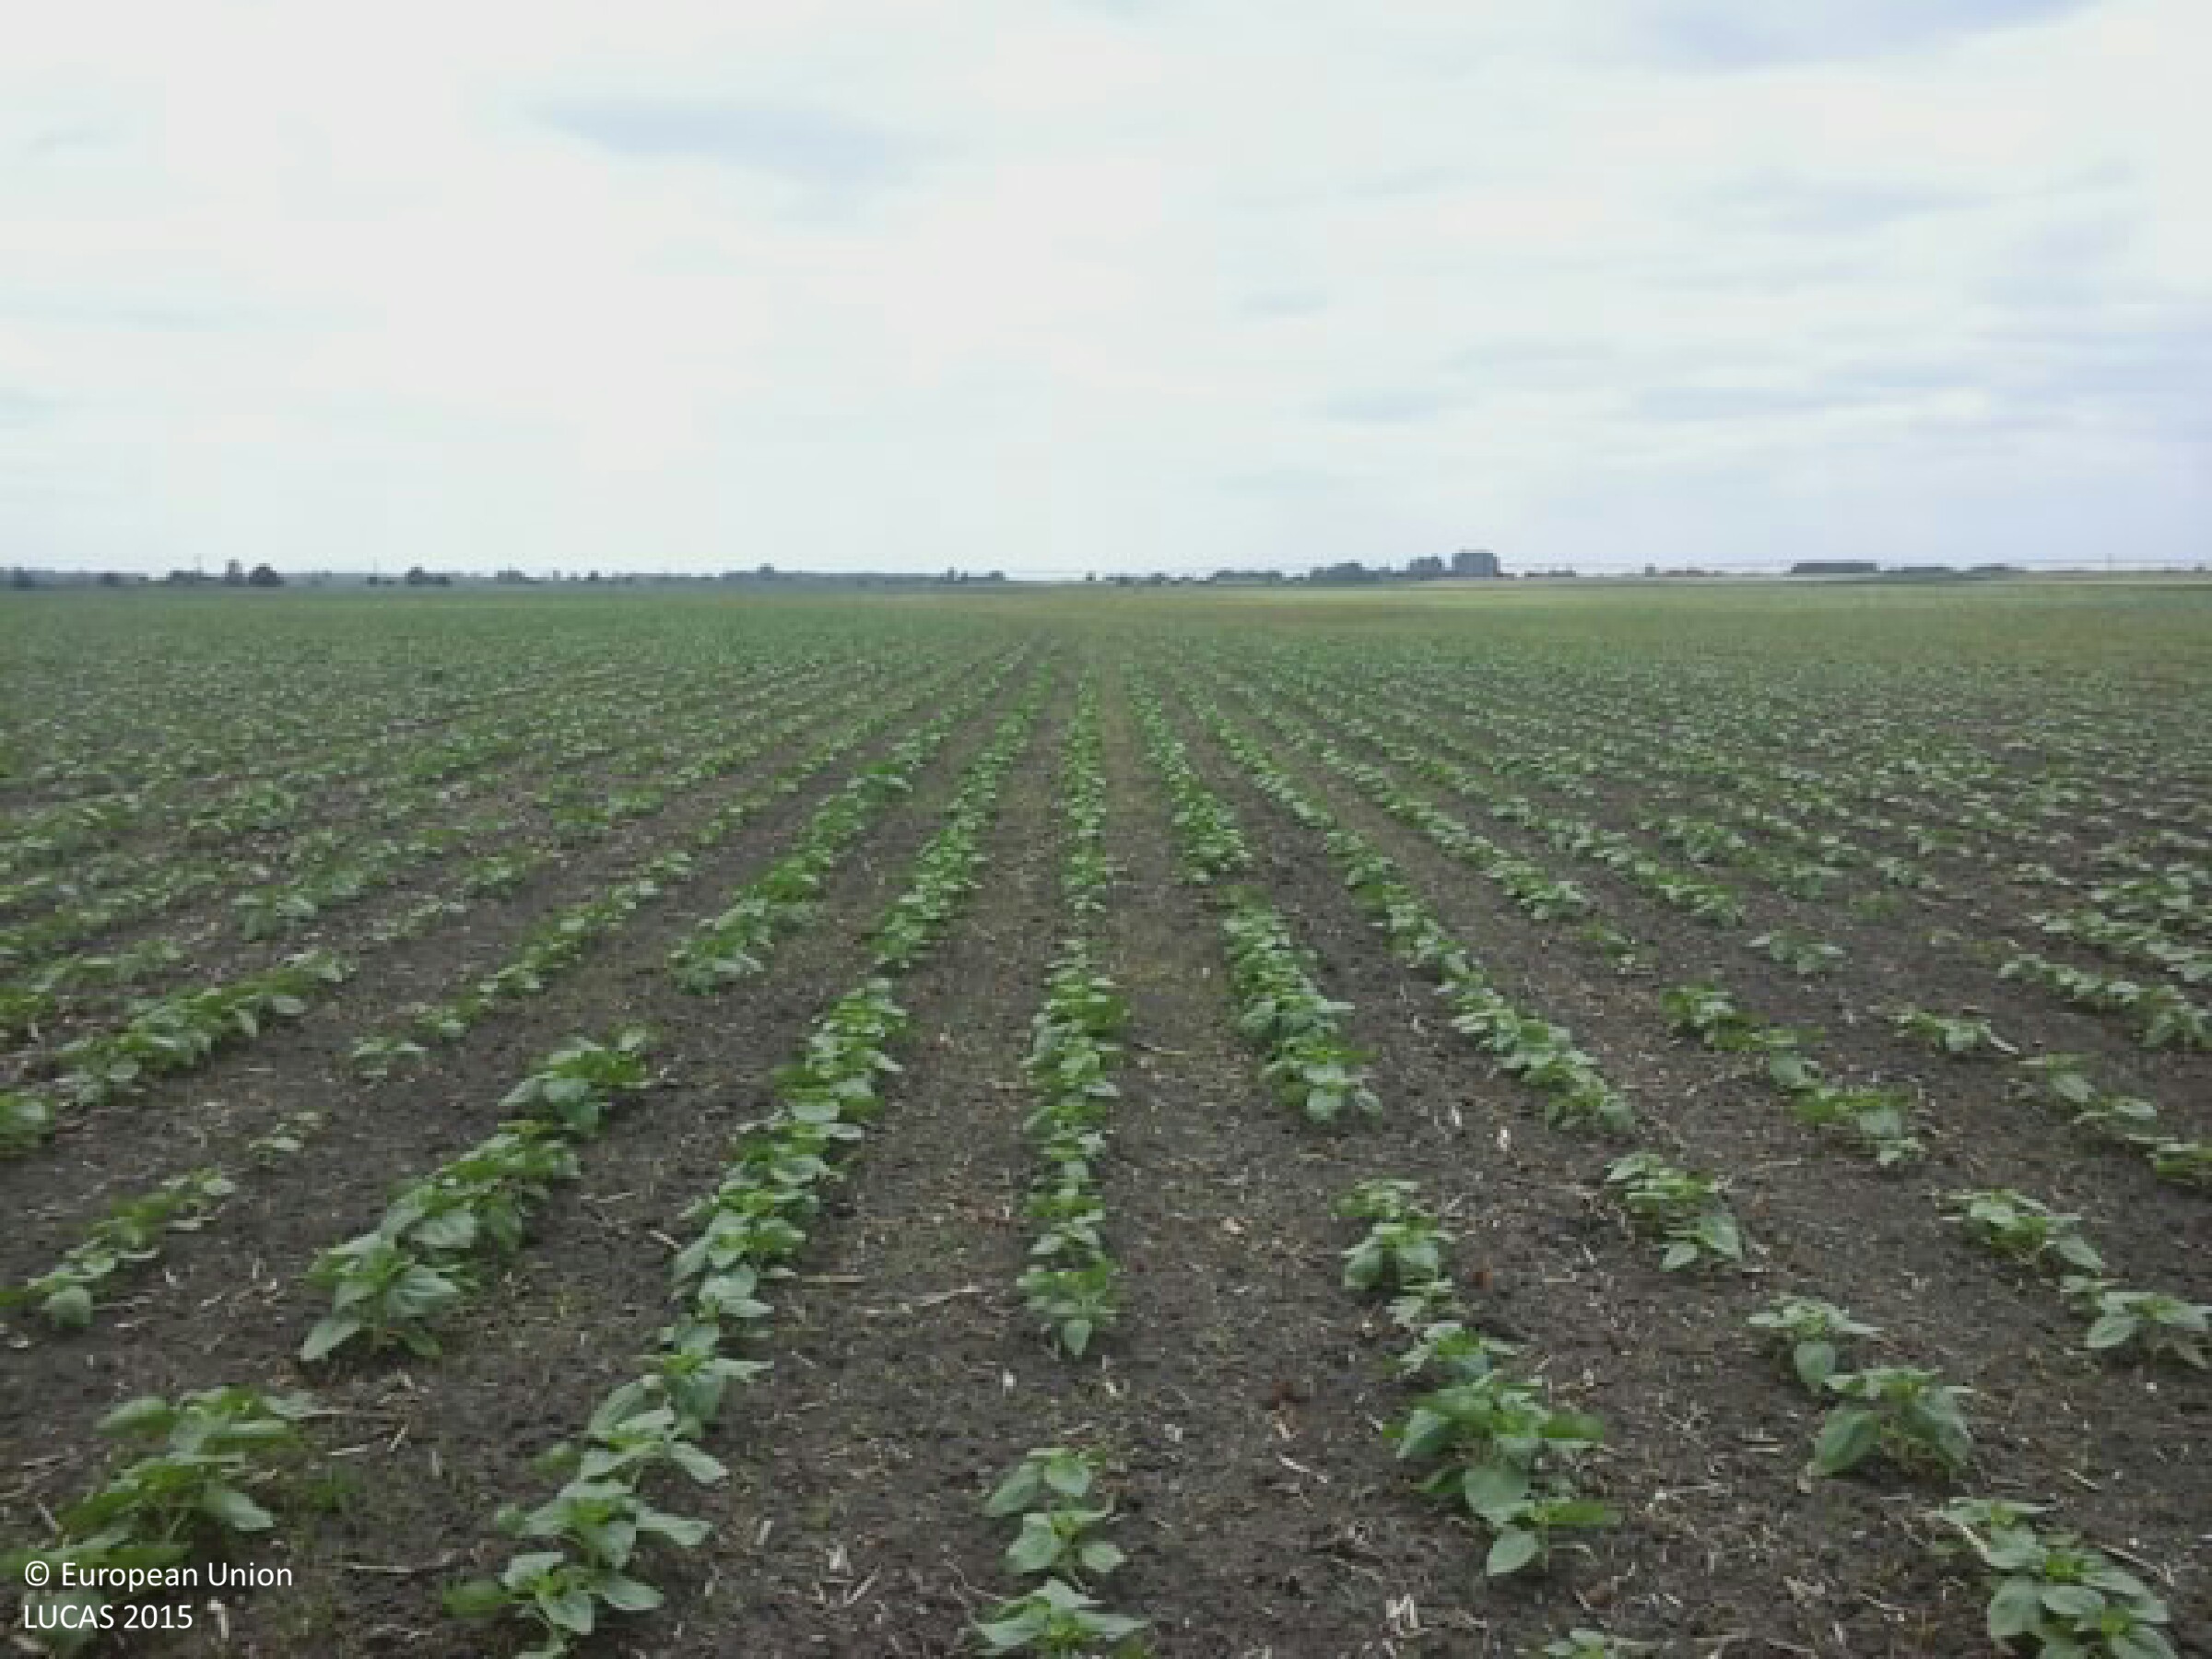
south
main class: Cropland
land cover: Sunflower
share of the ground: 10 - 25 %
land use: Agriculture (excluding fallow land and kitchen gardens)
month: June
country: HU
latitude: 46.1687
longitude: 20.0323
